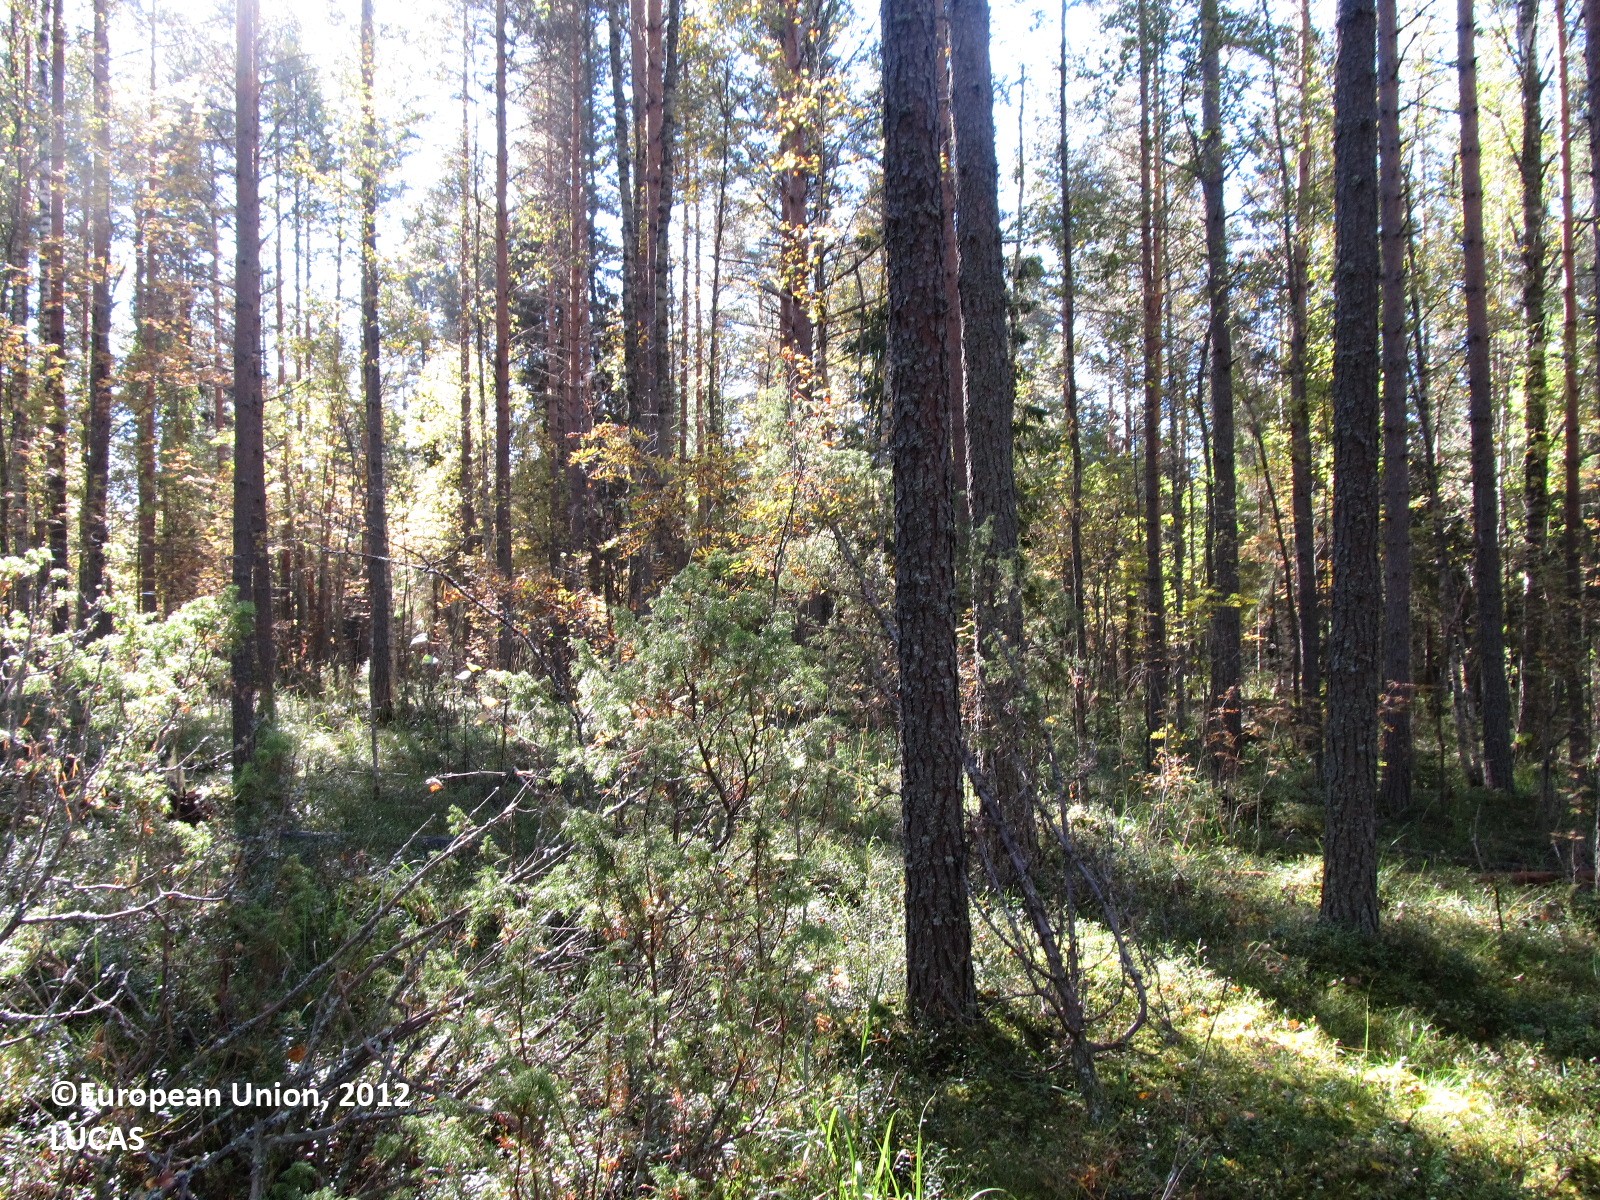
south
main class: Woodland
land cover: Pine dominated coniferous woodland
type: boreal forest
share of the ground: 25 - 50 %
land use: Forestry
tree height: > 5 m
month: September
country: FI
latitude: 62.4897
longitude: 28.2194
